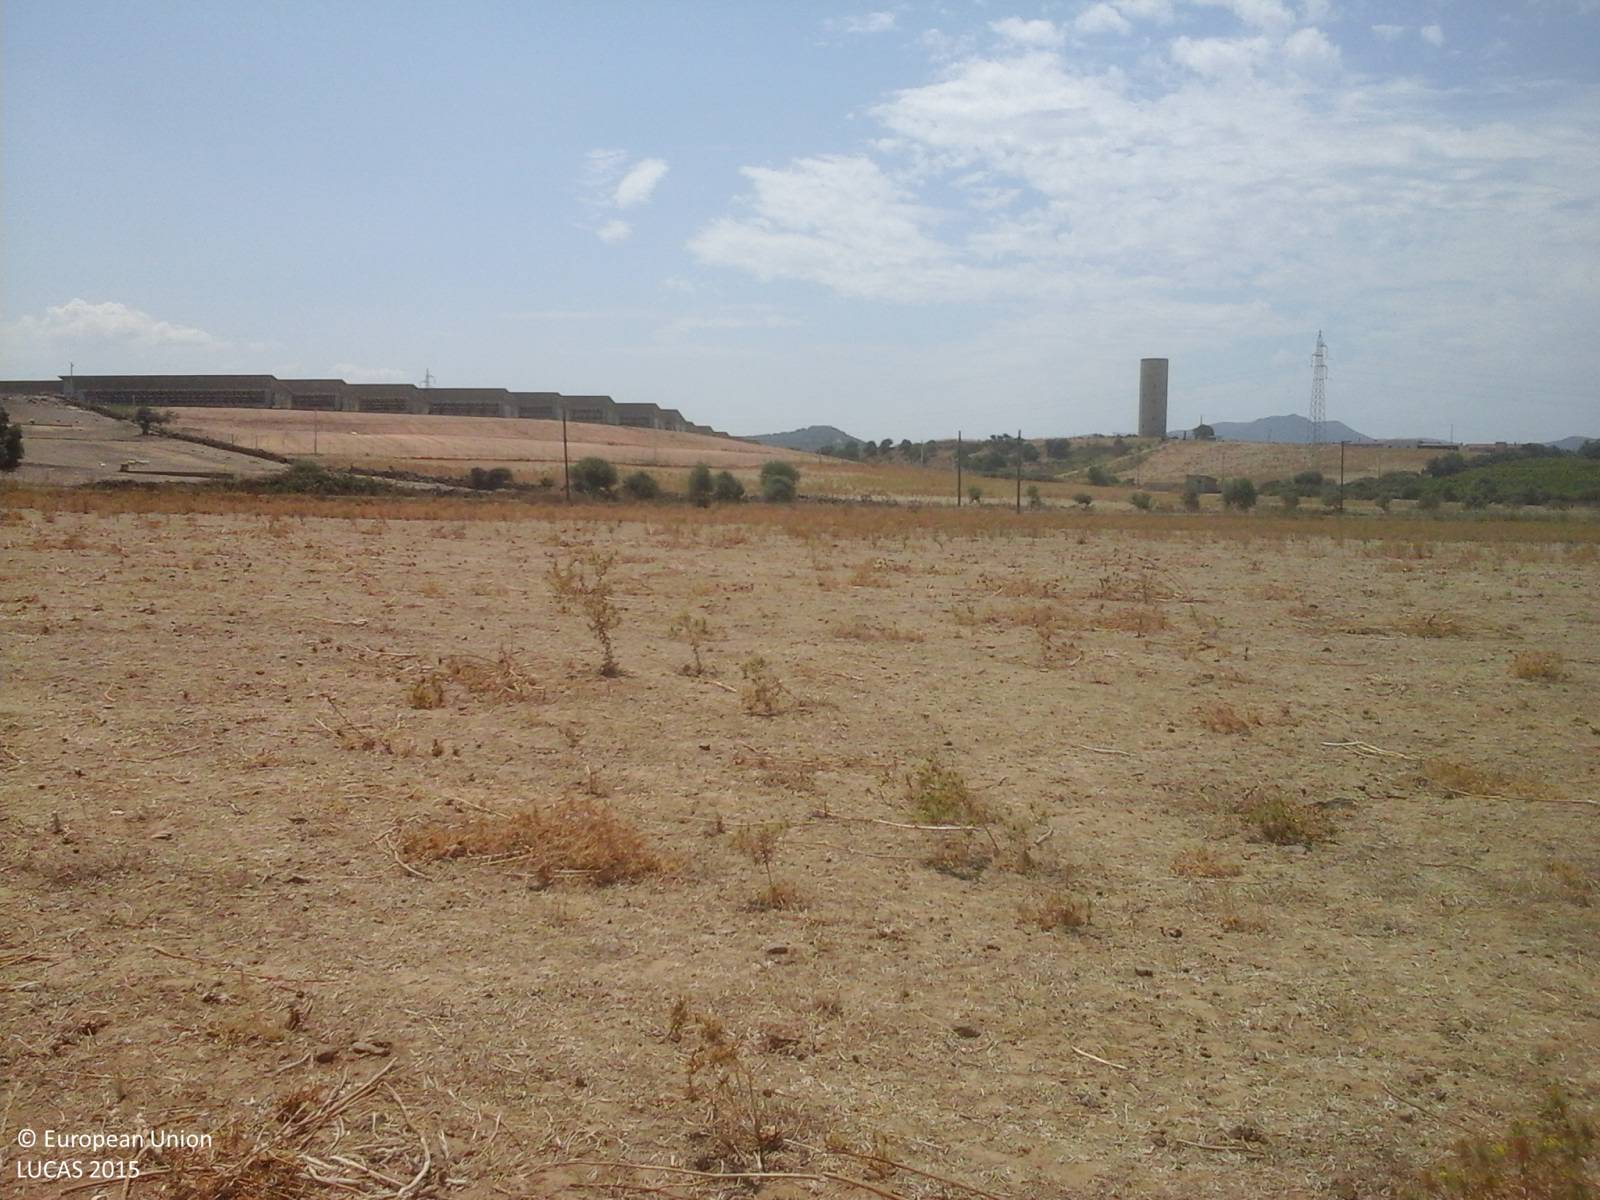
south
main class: Grassland
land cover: Grassland without tree/shrub cover
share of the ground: > 75 %
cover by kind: herbaceous plants 75 %, unconsolidated bare surface 20 %, consolidated bare surface 5 %
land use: Agriculture (excluding fallow land and kitchen gardens)
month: July
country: IT
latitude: 39.1172
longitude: 8.6783
